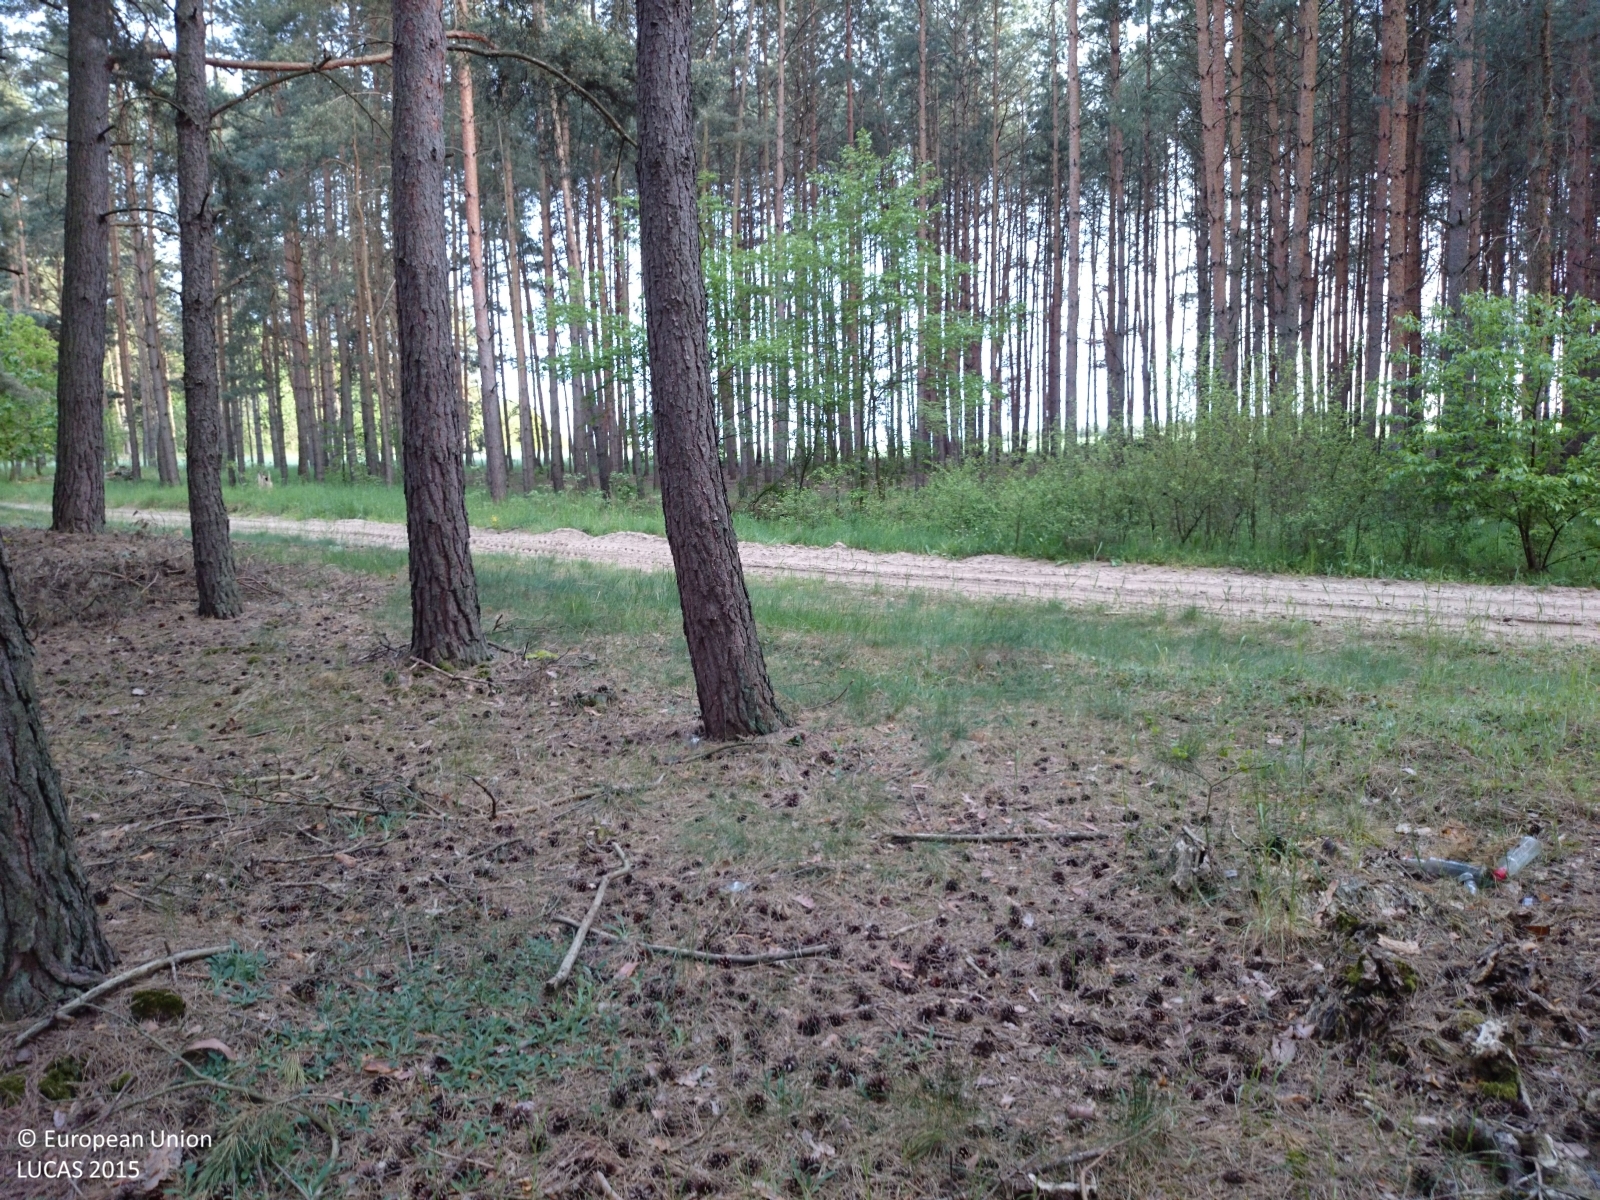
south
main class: Woodland
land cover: Pine dominated coniferous woodland
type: hemiboreal forest and nemoral coniferous forest and mixed broadleaved-coniferous forest
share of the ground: > 75 %
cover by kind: coniferous forest trees 100 %
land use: Forestry
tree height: > 5 m
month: May
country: PL
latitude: 52.6093
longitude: 16.2531
